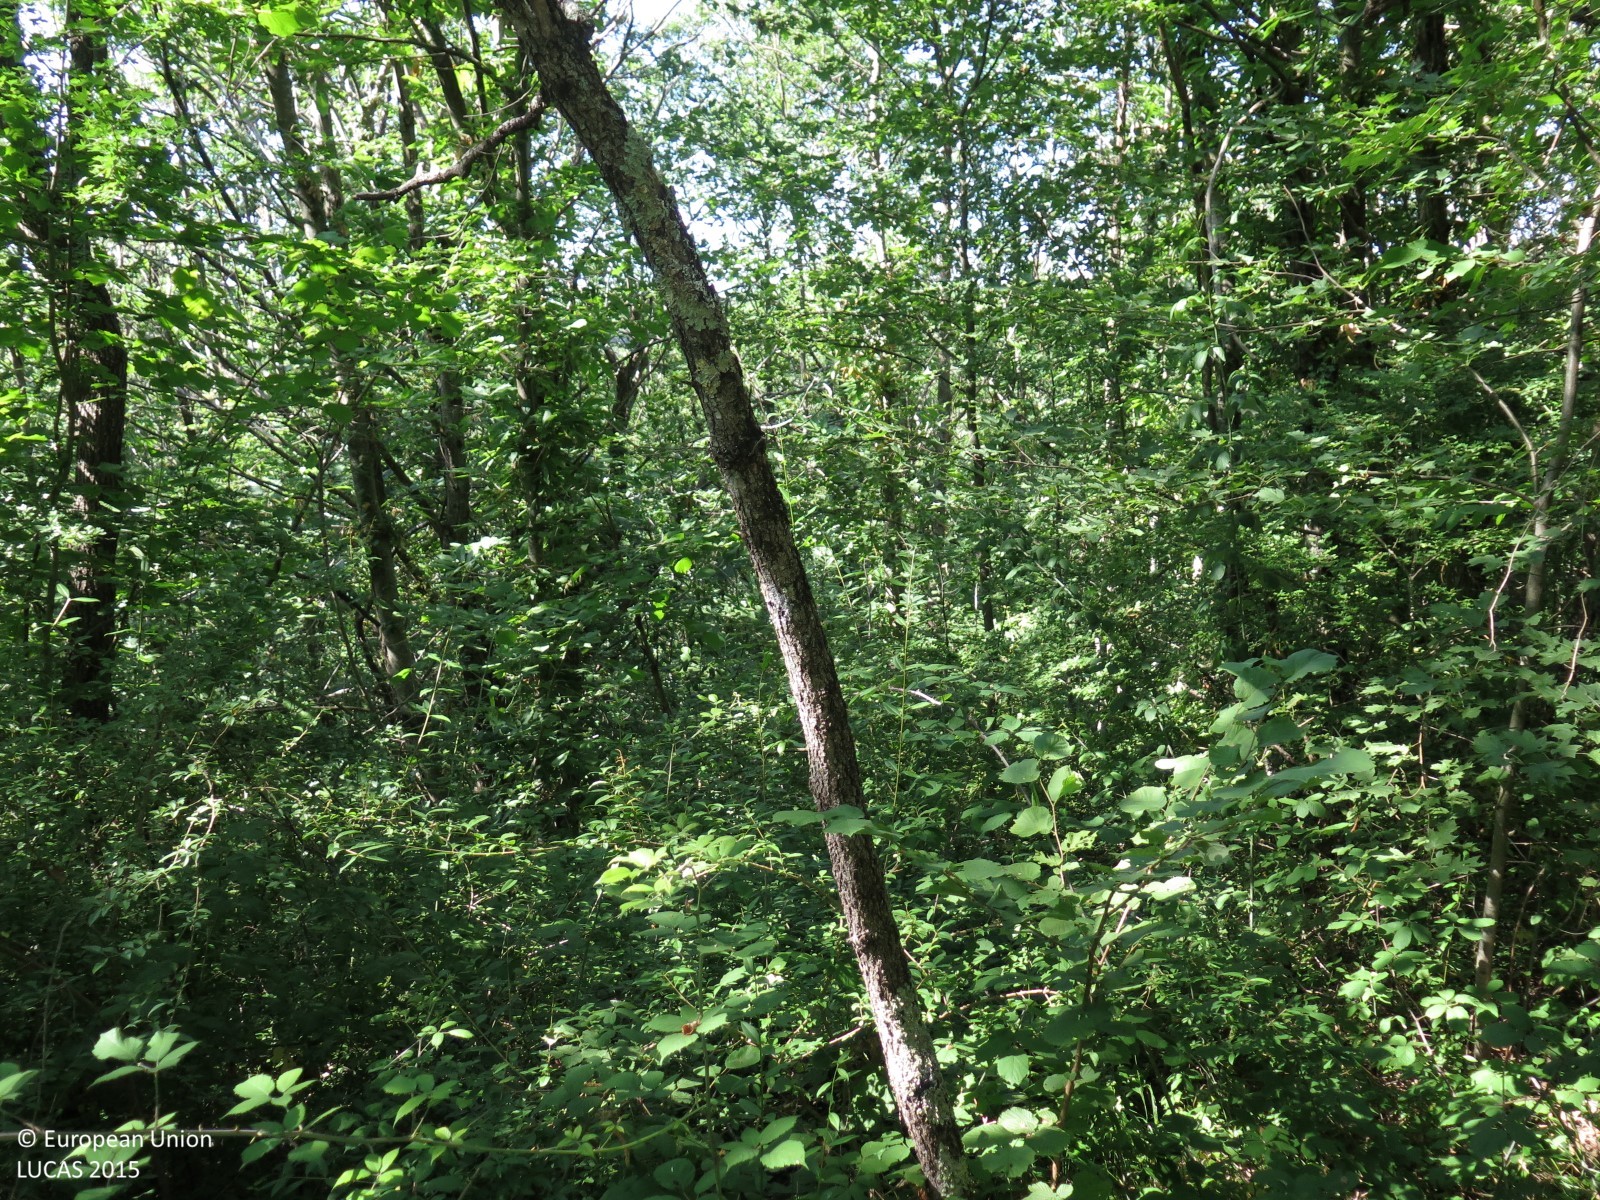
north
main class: Woodland
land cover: Broadleaved woodland
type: mesophytic deciduous forest
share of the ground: > 75 %
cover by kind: broadleaved forest trees 95 %, herbaceous plants 5 %
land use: Semi-natural and natural areas not in use
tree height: > 5 m
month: July
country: HR
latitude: 45.2707
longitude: 13.8824
